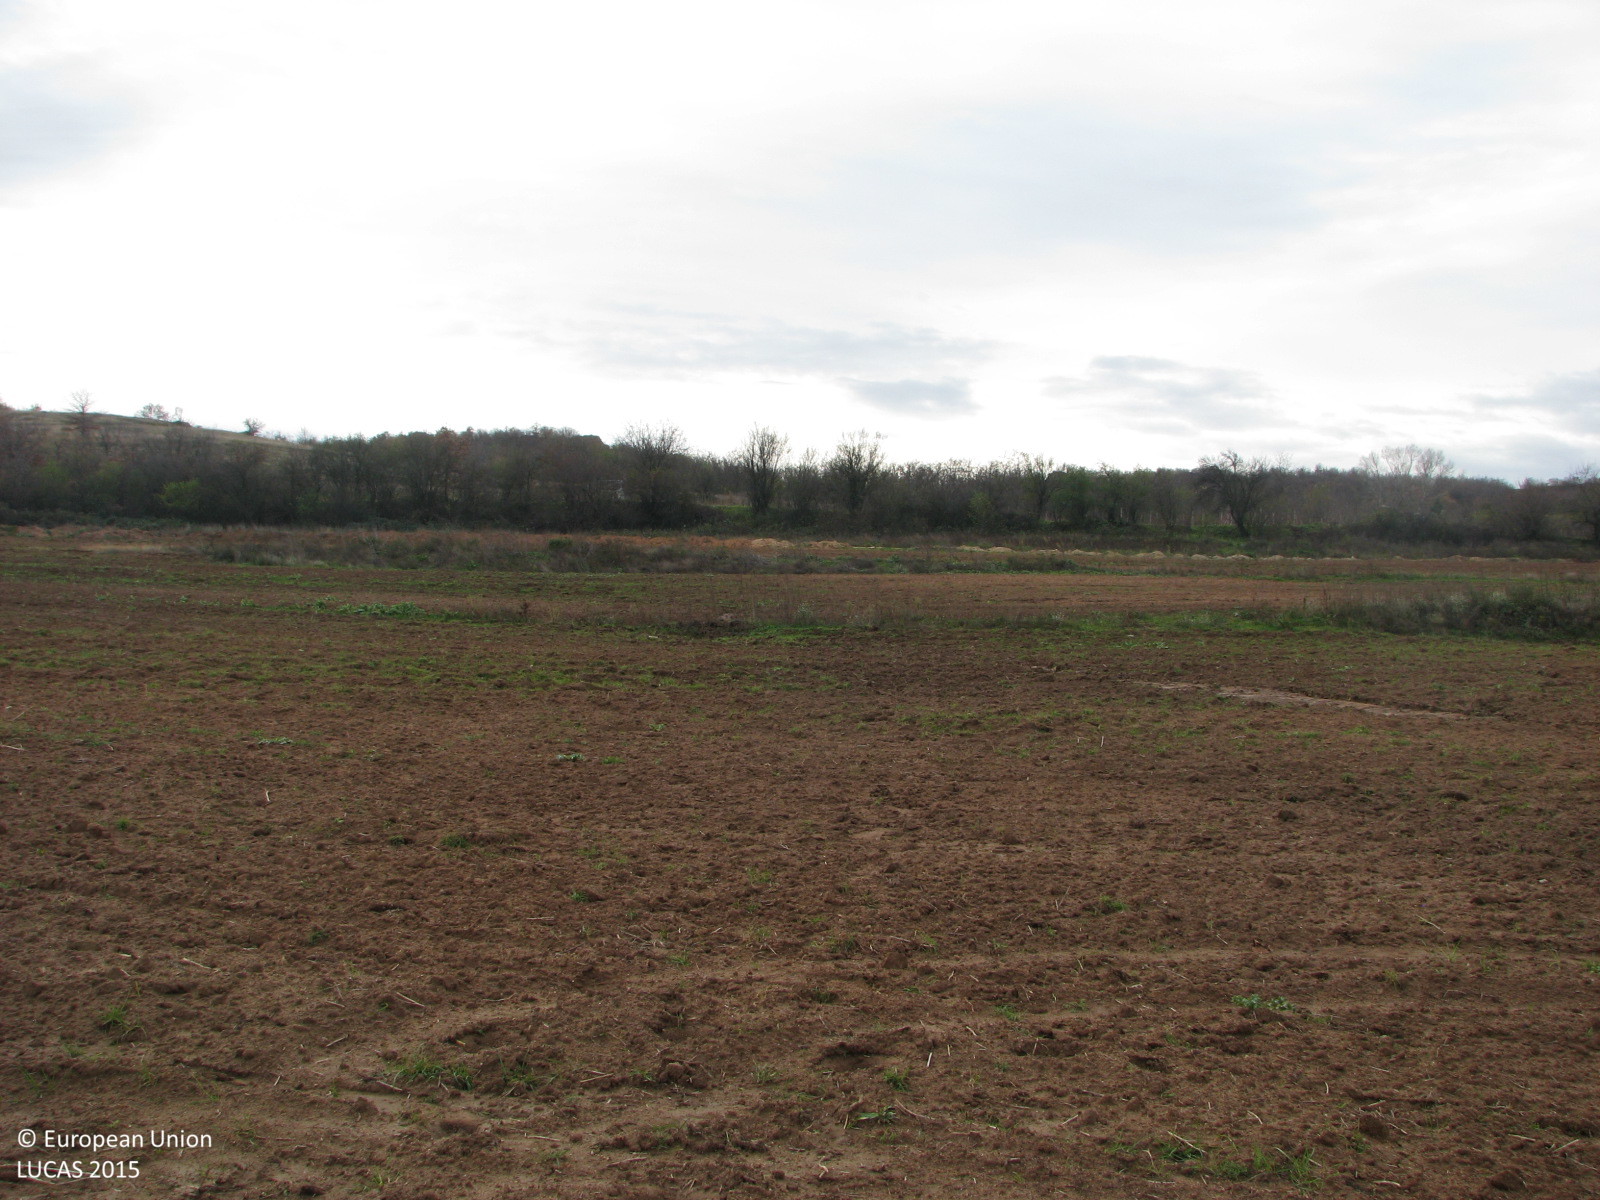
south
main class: Cropland
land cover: Other fruit trees and berries
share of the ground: 25 - 50 %
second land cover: Spontaneously vegetated surfaces
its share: 25 - 50 %
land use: Agriculture (excluding fallow land and kitchen gardens)
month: December
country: BG
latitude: 42.6230
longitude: 24.6743
